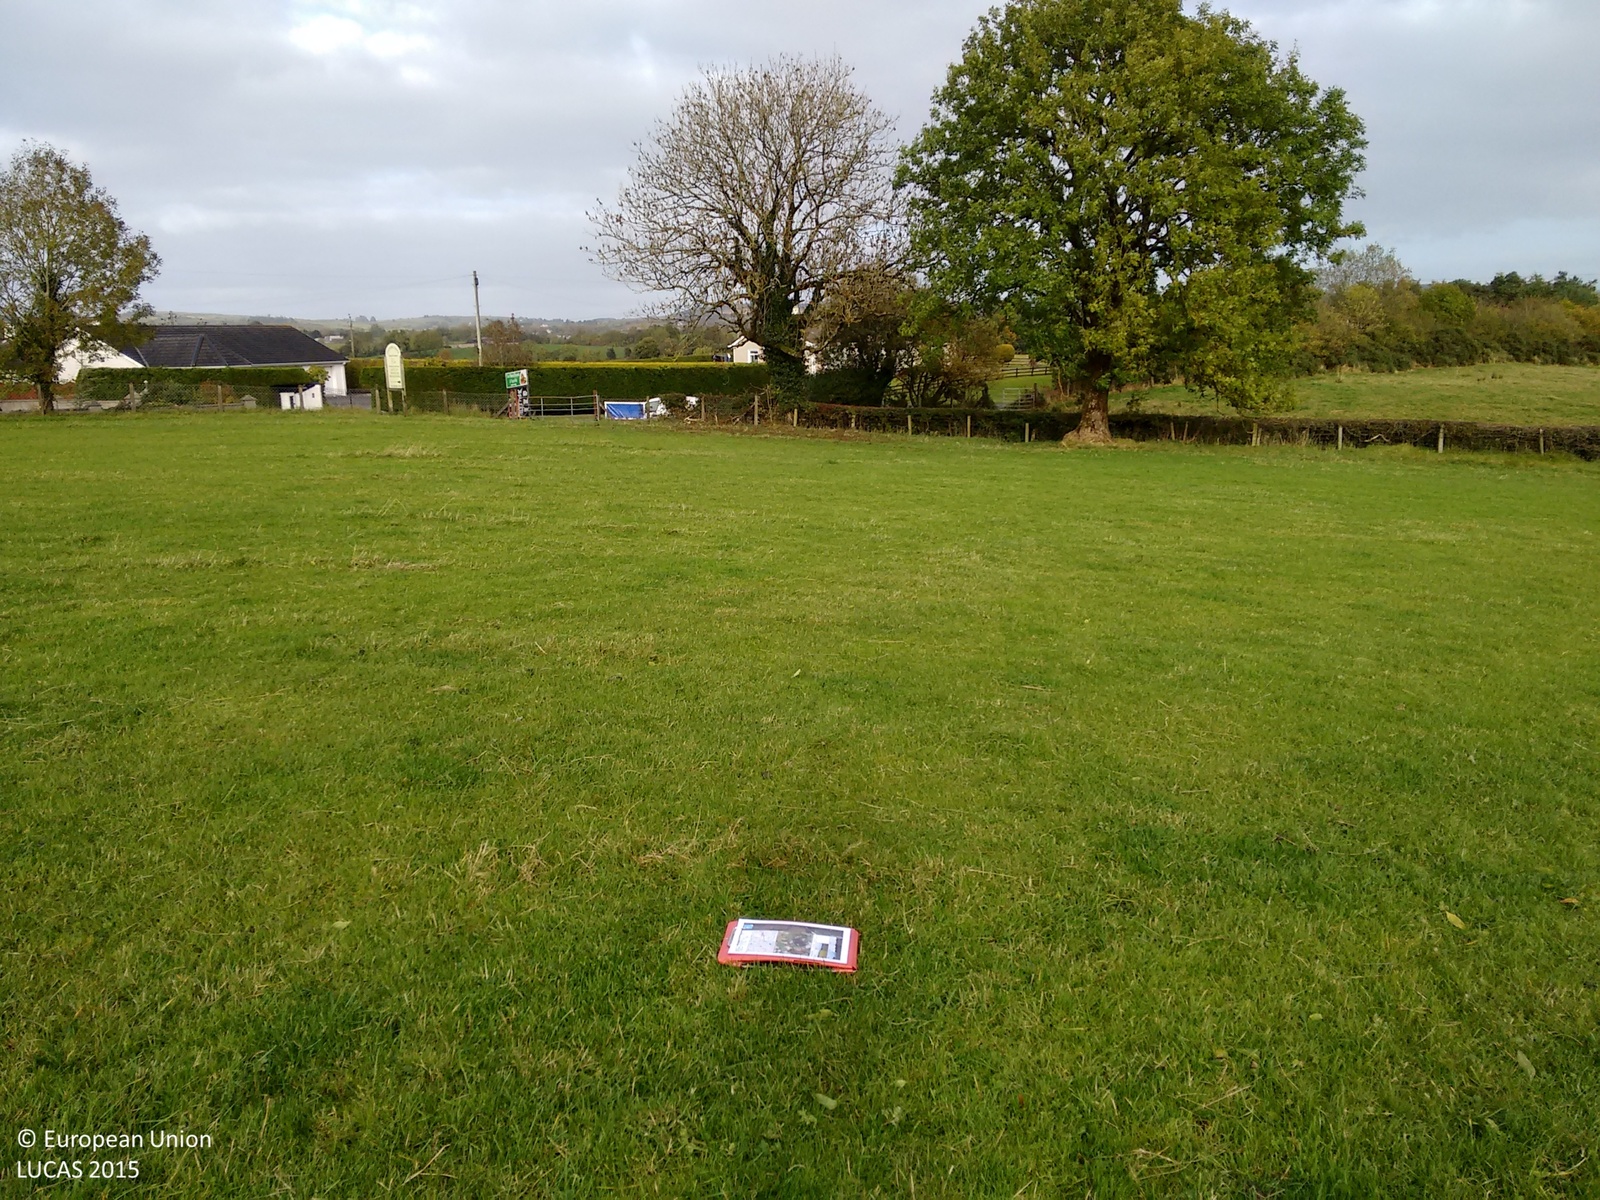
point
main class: Grassland
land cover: Grassland without tree/shrub cover
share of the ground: > 75 %
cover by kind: herbaceous plants 100 %
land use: Agriculture (excluding fallow land and kitchen gardens)
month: October
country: GB
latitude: 54.3919
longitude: -7.4176
